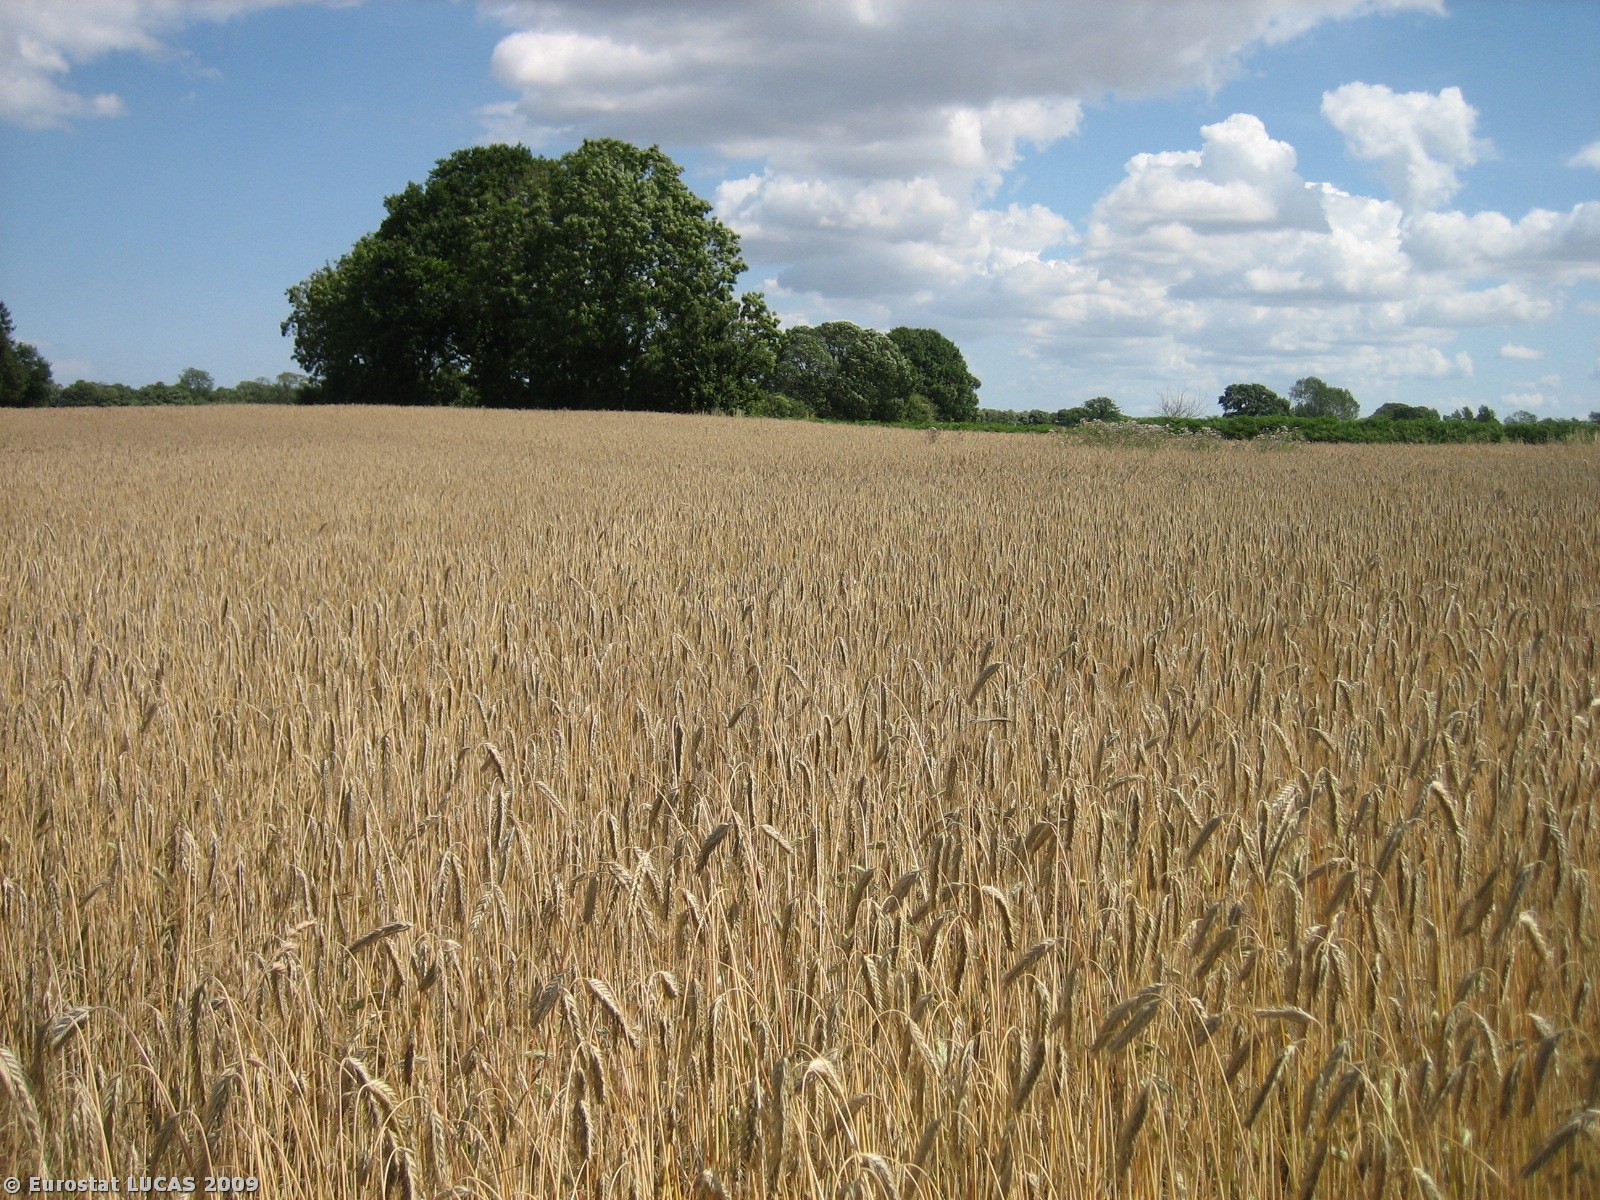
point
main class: Cropland
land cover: Rye
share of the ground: > 75 %
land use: Agriculture (excluding fallow land and kitchen gardens)
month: July
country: DK
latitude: 55.5047
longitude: 10.0158
